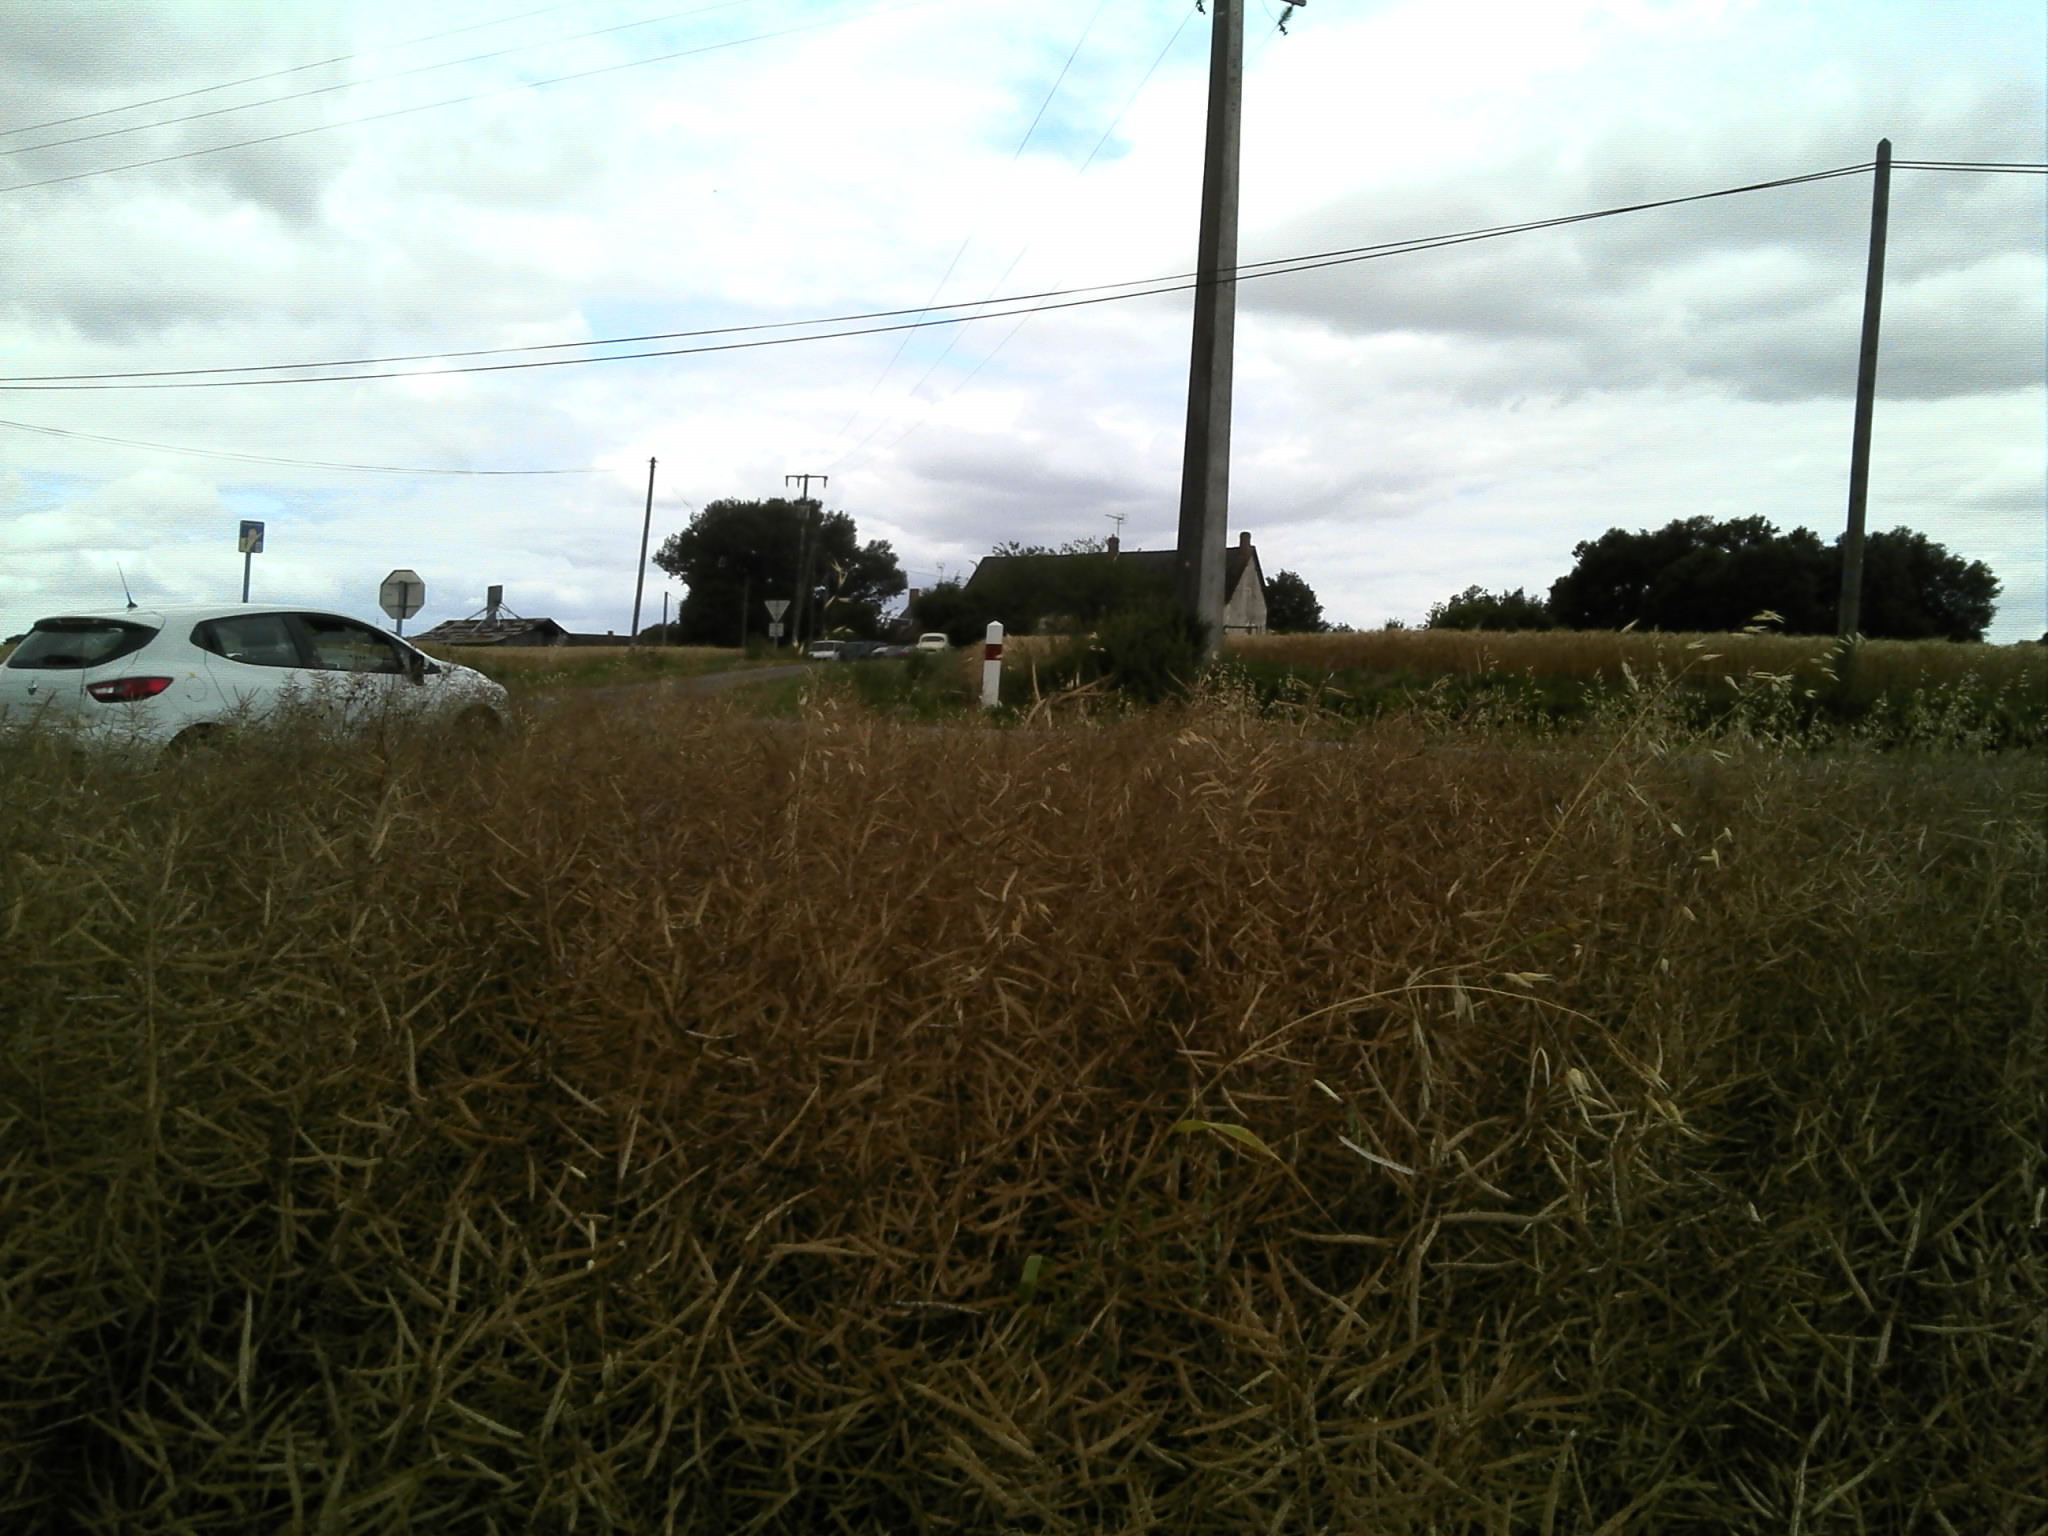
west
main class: Cropland
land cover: Rape and turnip rape
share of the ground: > 75 %
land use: Agriculture (excluding fallow land and kitchen gardens)
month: July
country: FR
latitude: 46.9211
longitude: 1.0951
